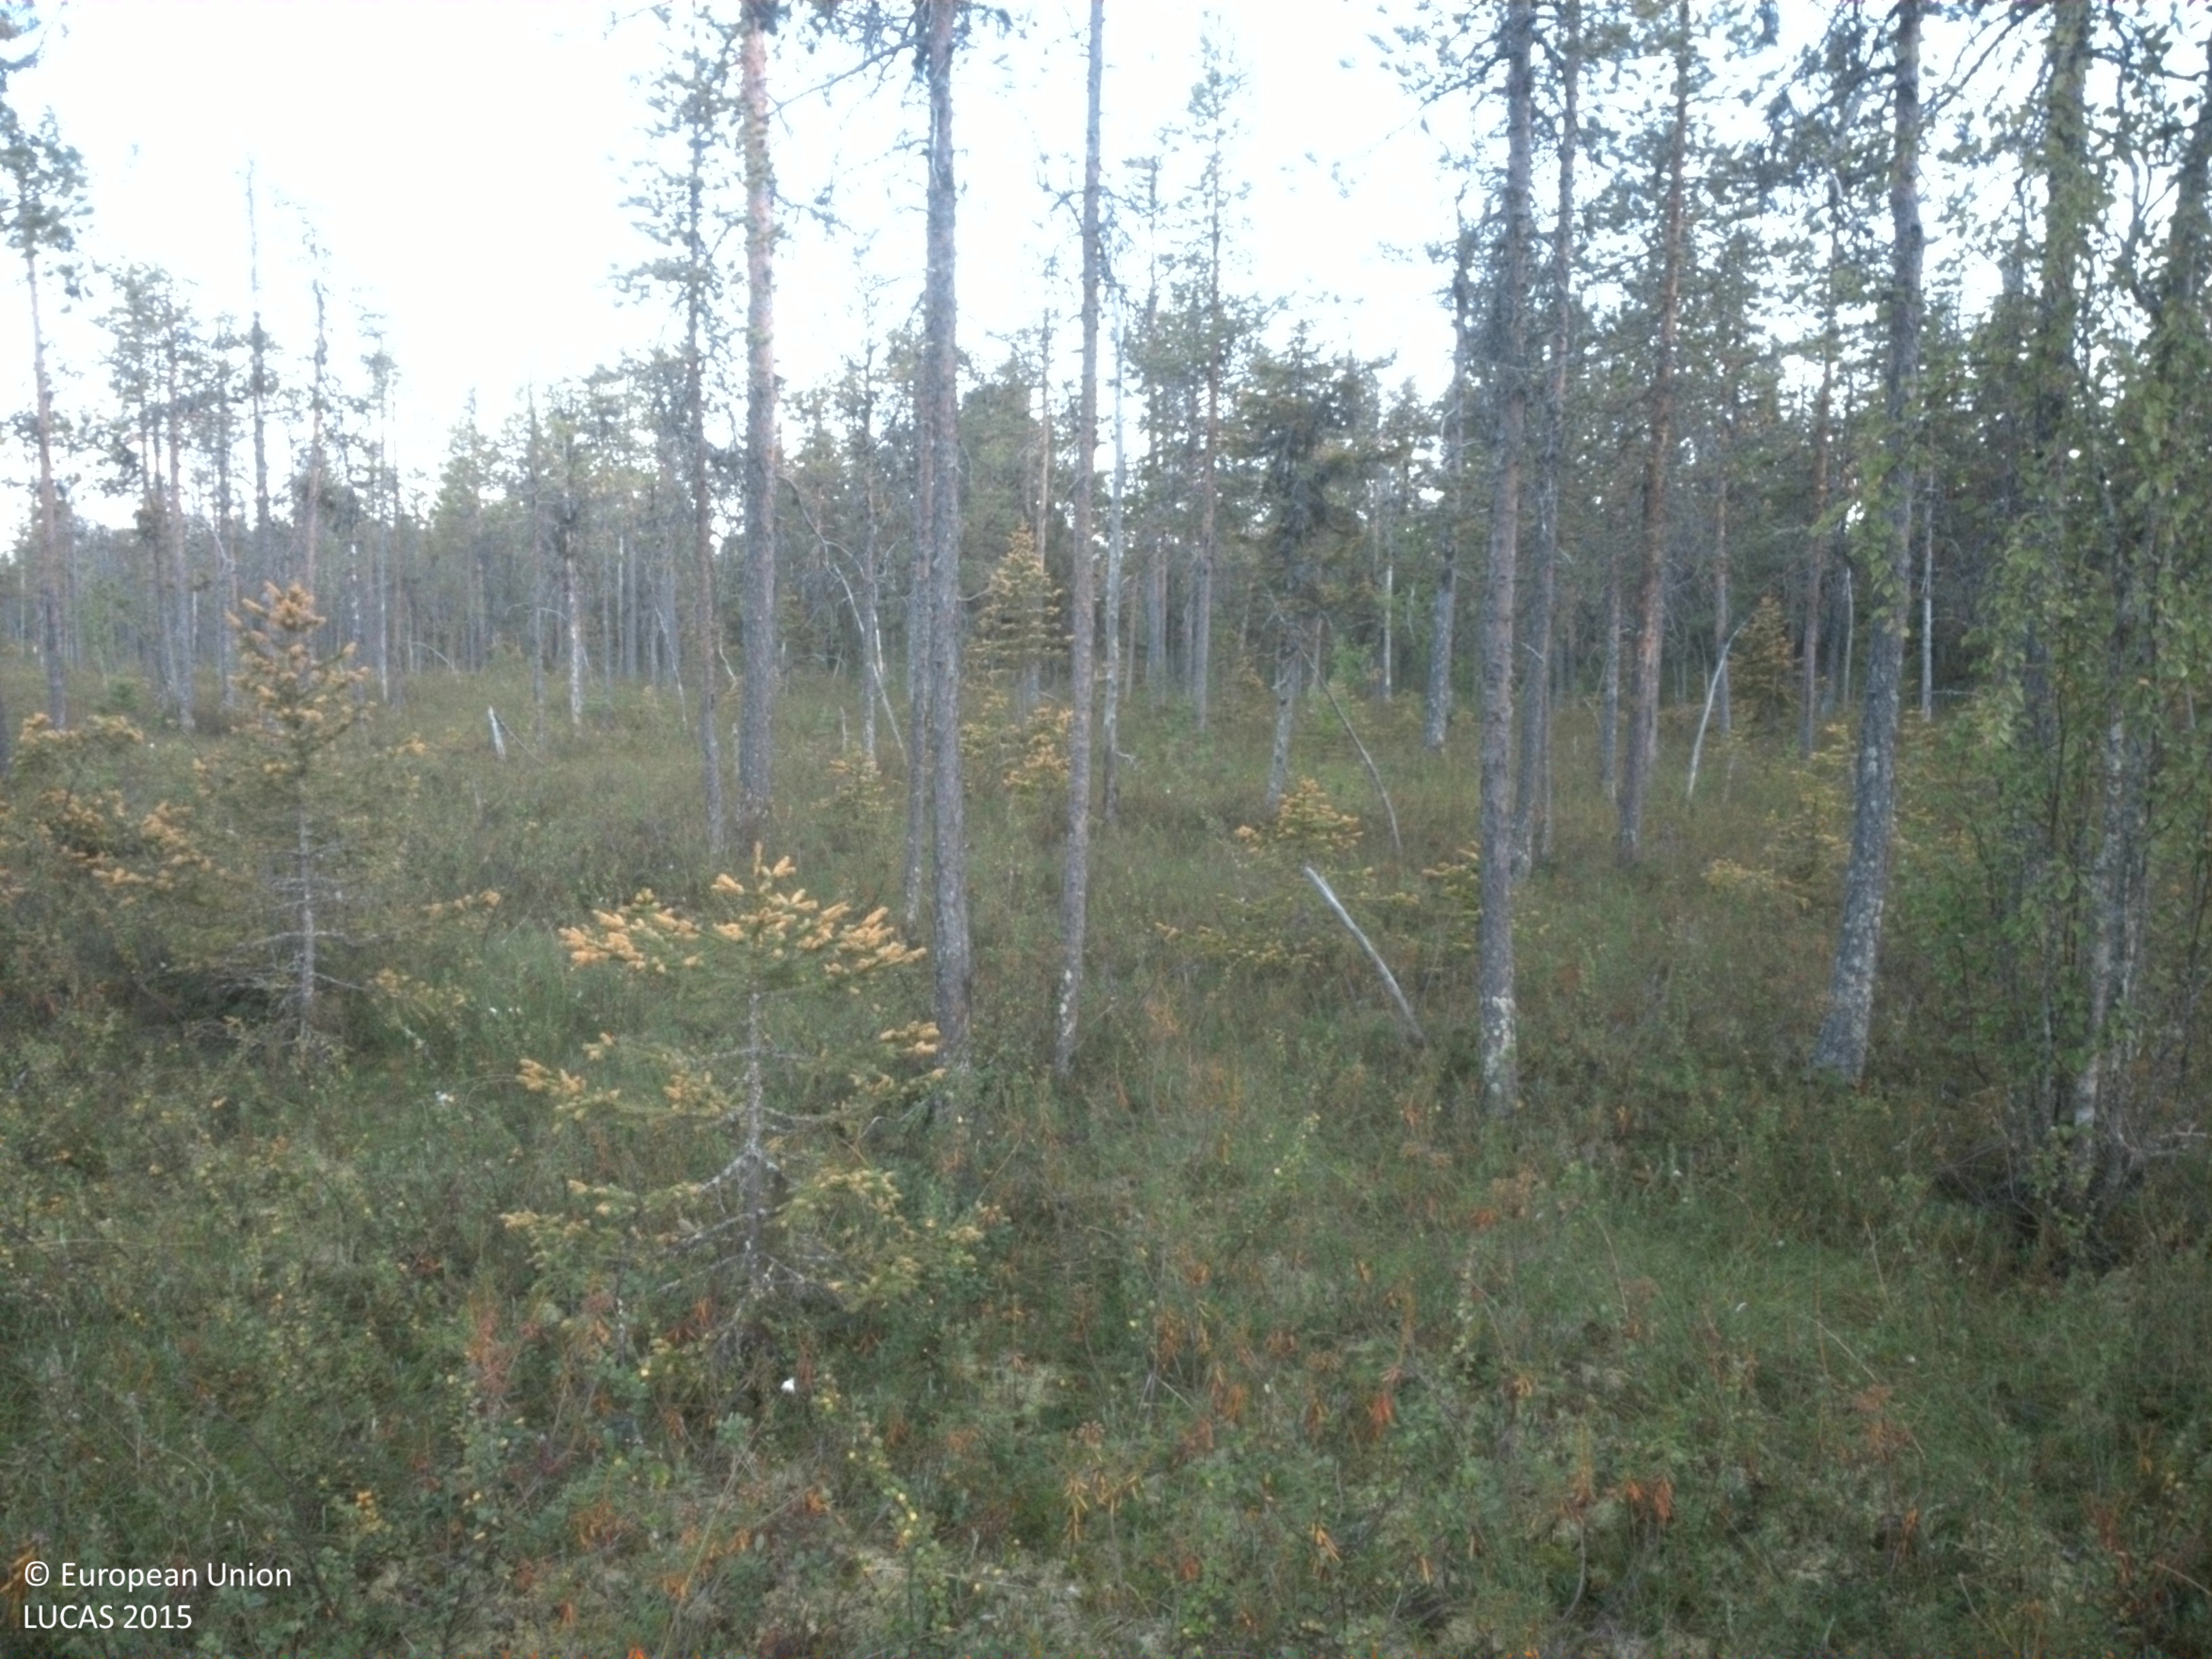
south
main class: Woodland
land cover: Pine dominated coniferous woodland
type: boreal forest
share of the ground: 10 - 25 %
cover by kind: shrubs 30 %, herbaceous plants 30 %, coniferous forest trees 20 %, lichens and mosses 20 %
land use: Forestry
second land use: Other primary production
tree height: > 5 m
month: August
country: SE
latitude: 64.6258
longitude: 18.8150
